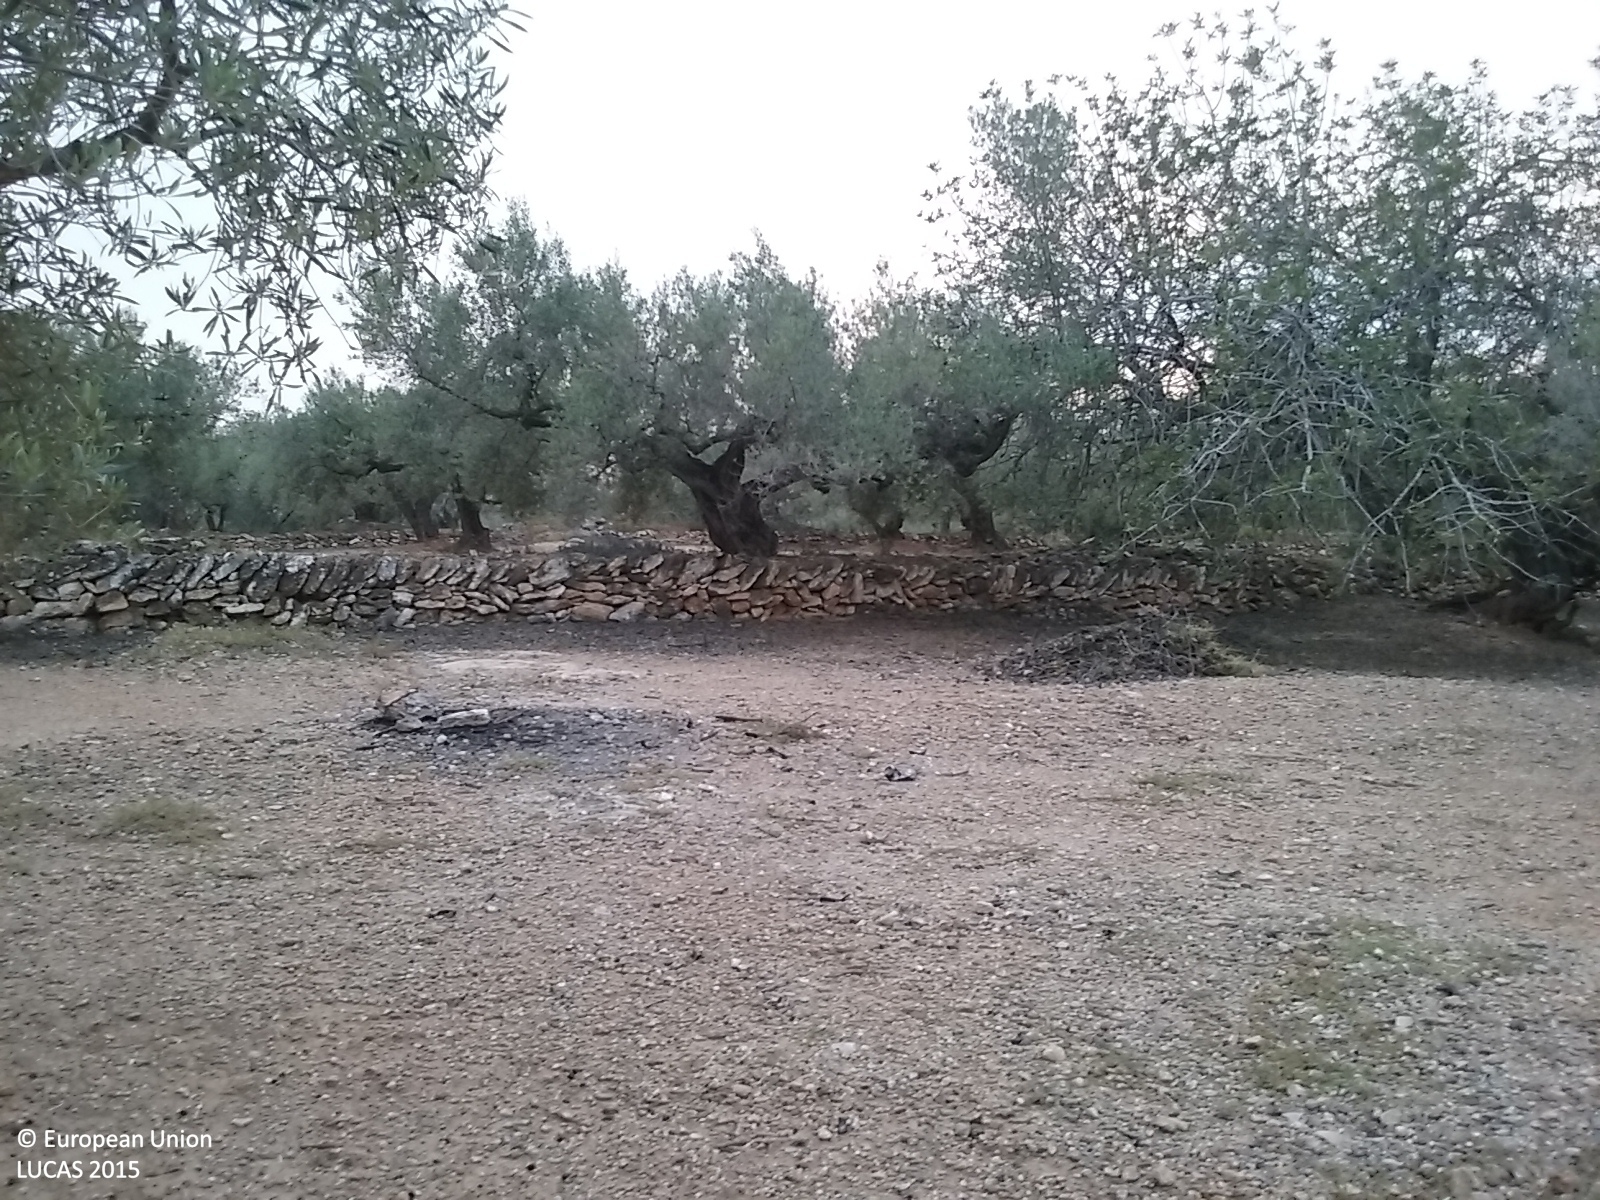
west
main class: Cropland
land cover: Olive groves
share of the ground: 25 - 50 %
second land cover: Other bare soil
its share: > 75 %
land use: Agriculture (excluding fallow land and kitchen gardens)
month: April
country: ES
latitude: 40.8444
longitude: 0.7074
